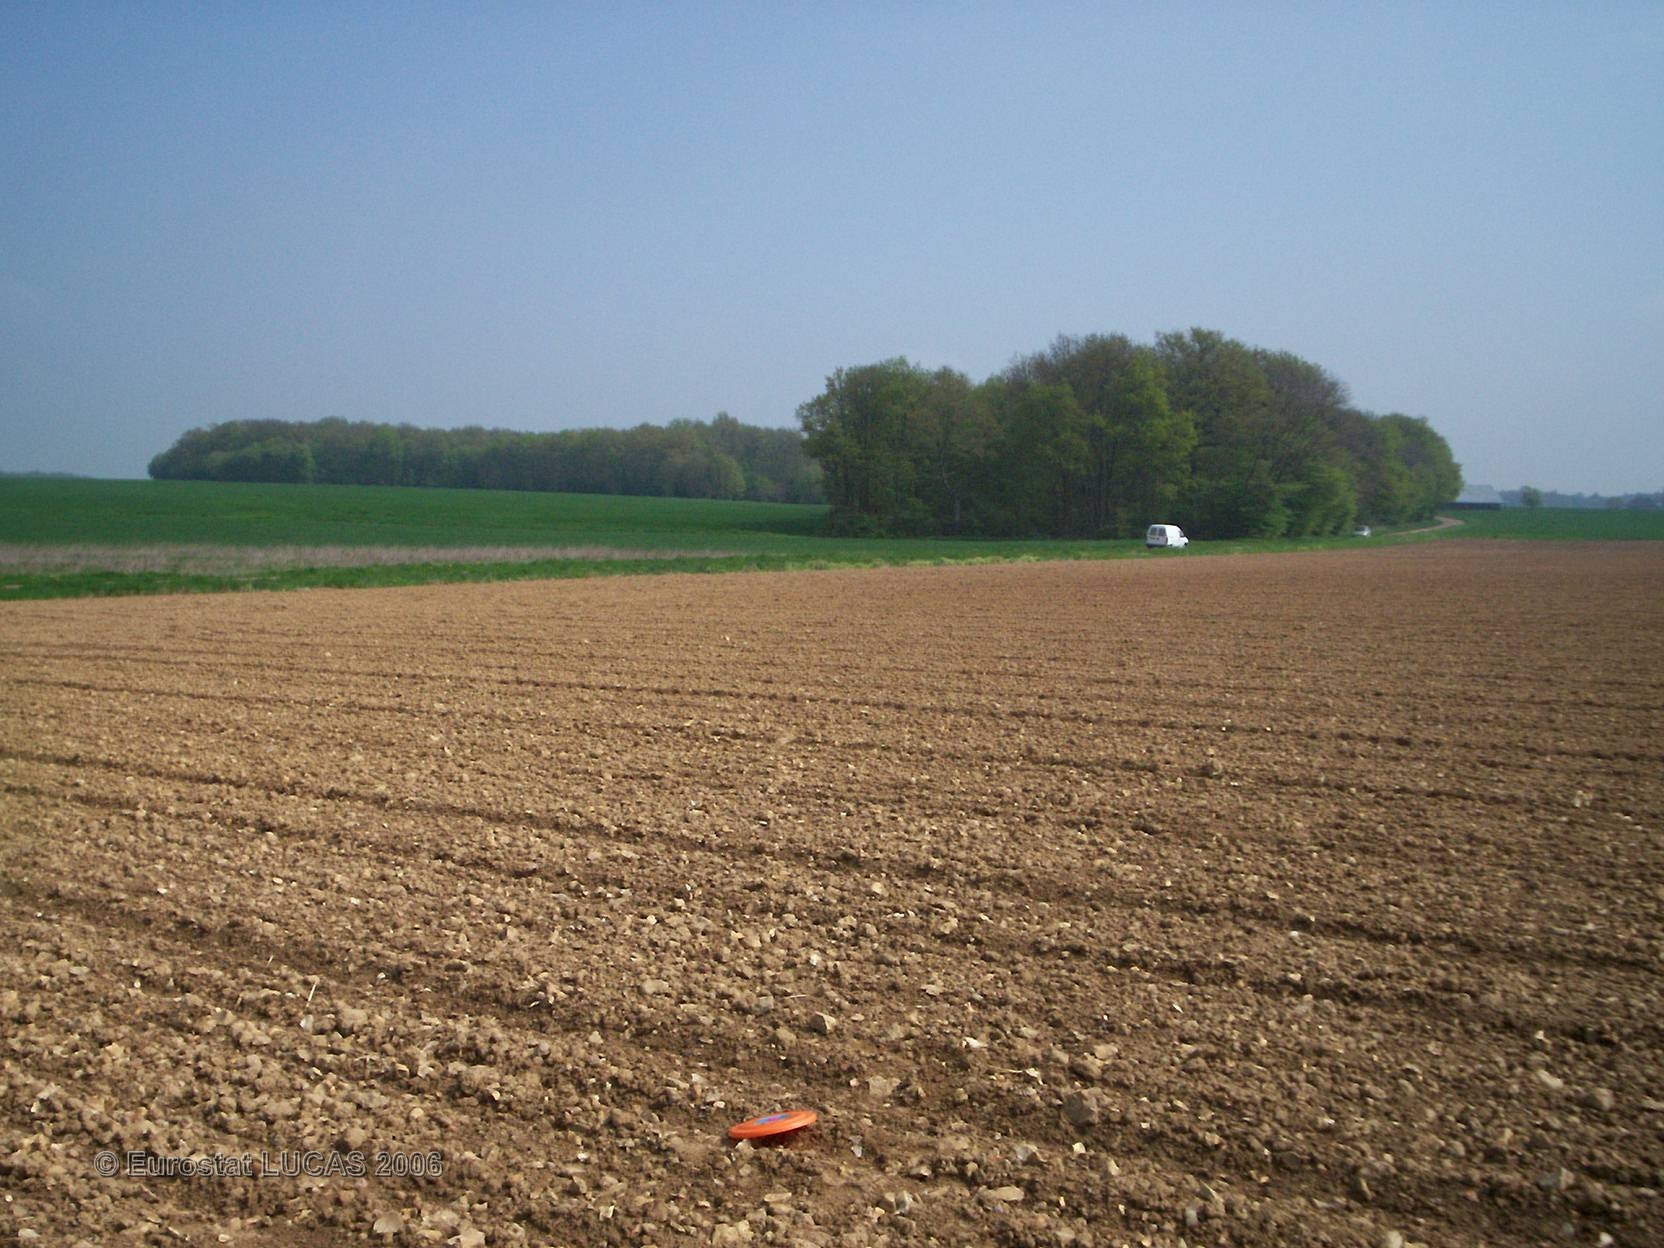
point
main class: Cropland
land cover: Sunflower
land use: Agriculture (excluding fallow land and kitchen gardens)
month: April
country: FR
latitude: 47.9572
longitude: 2.8816
